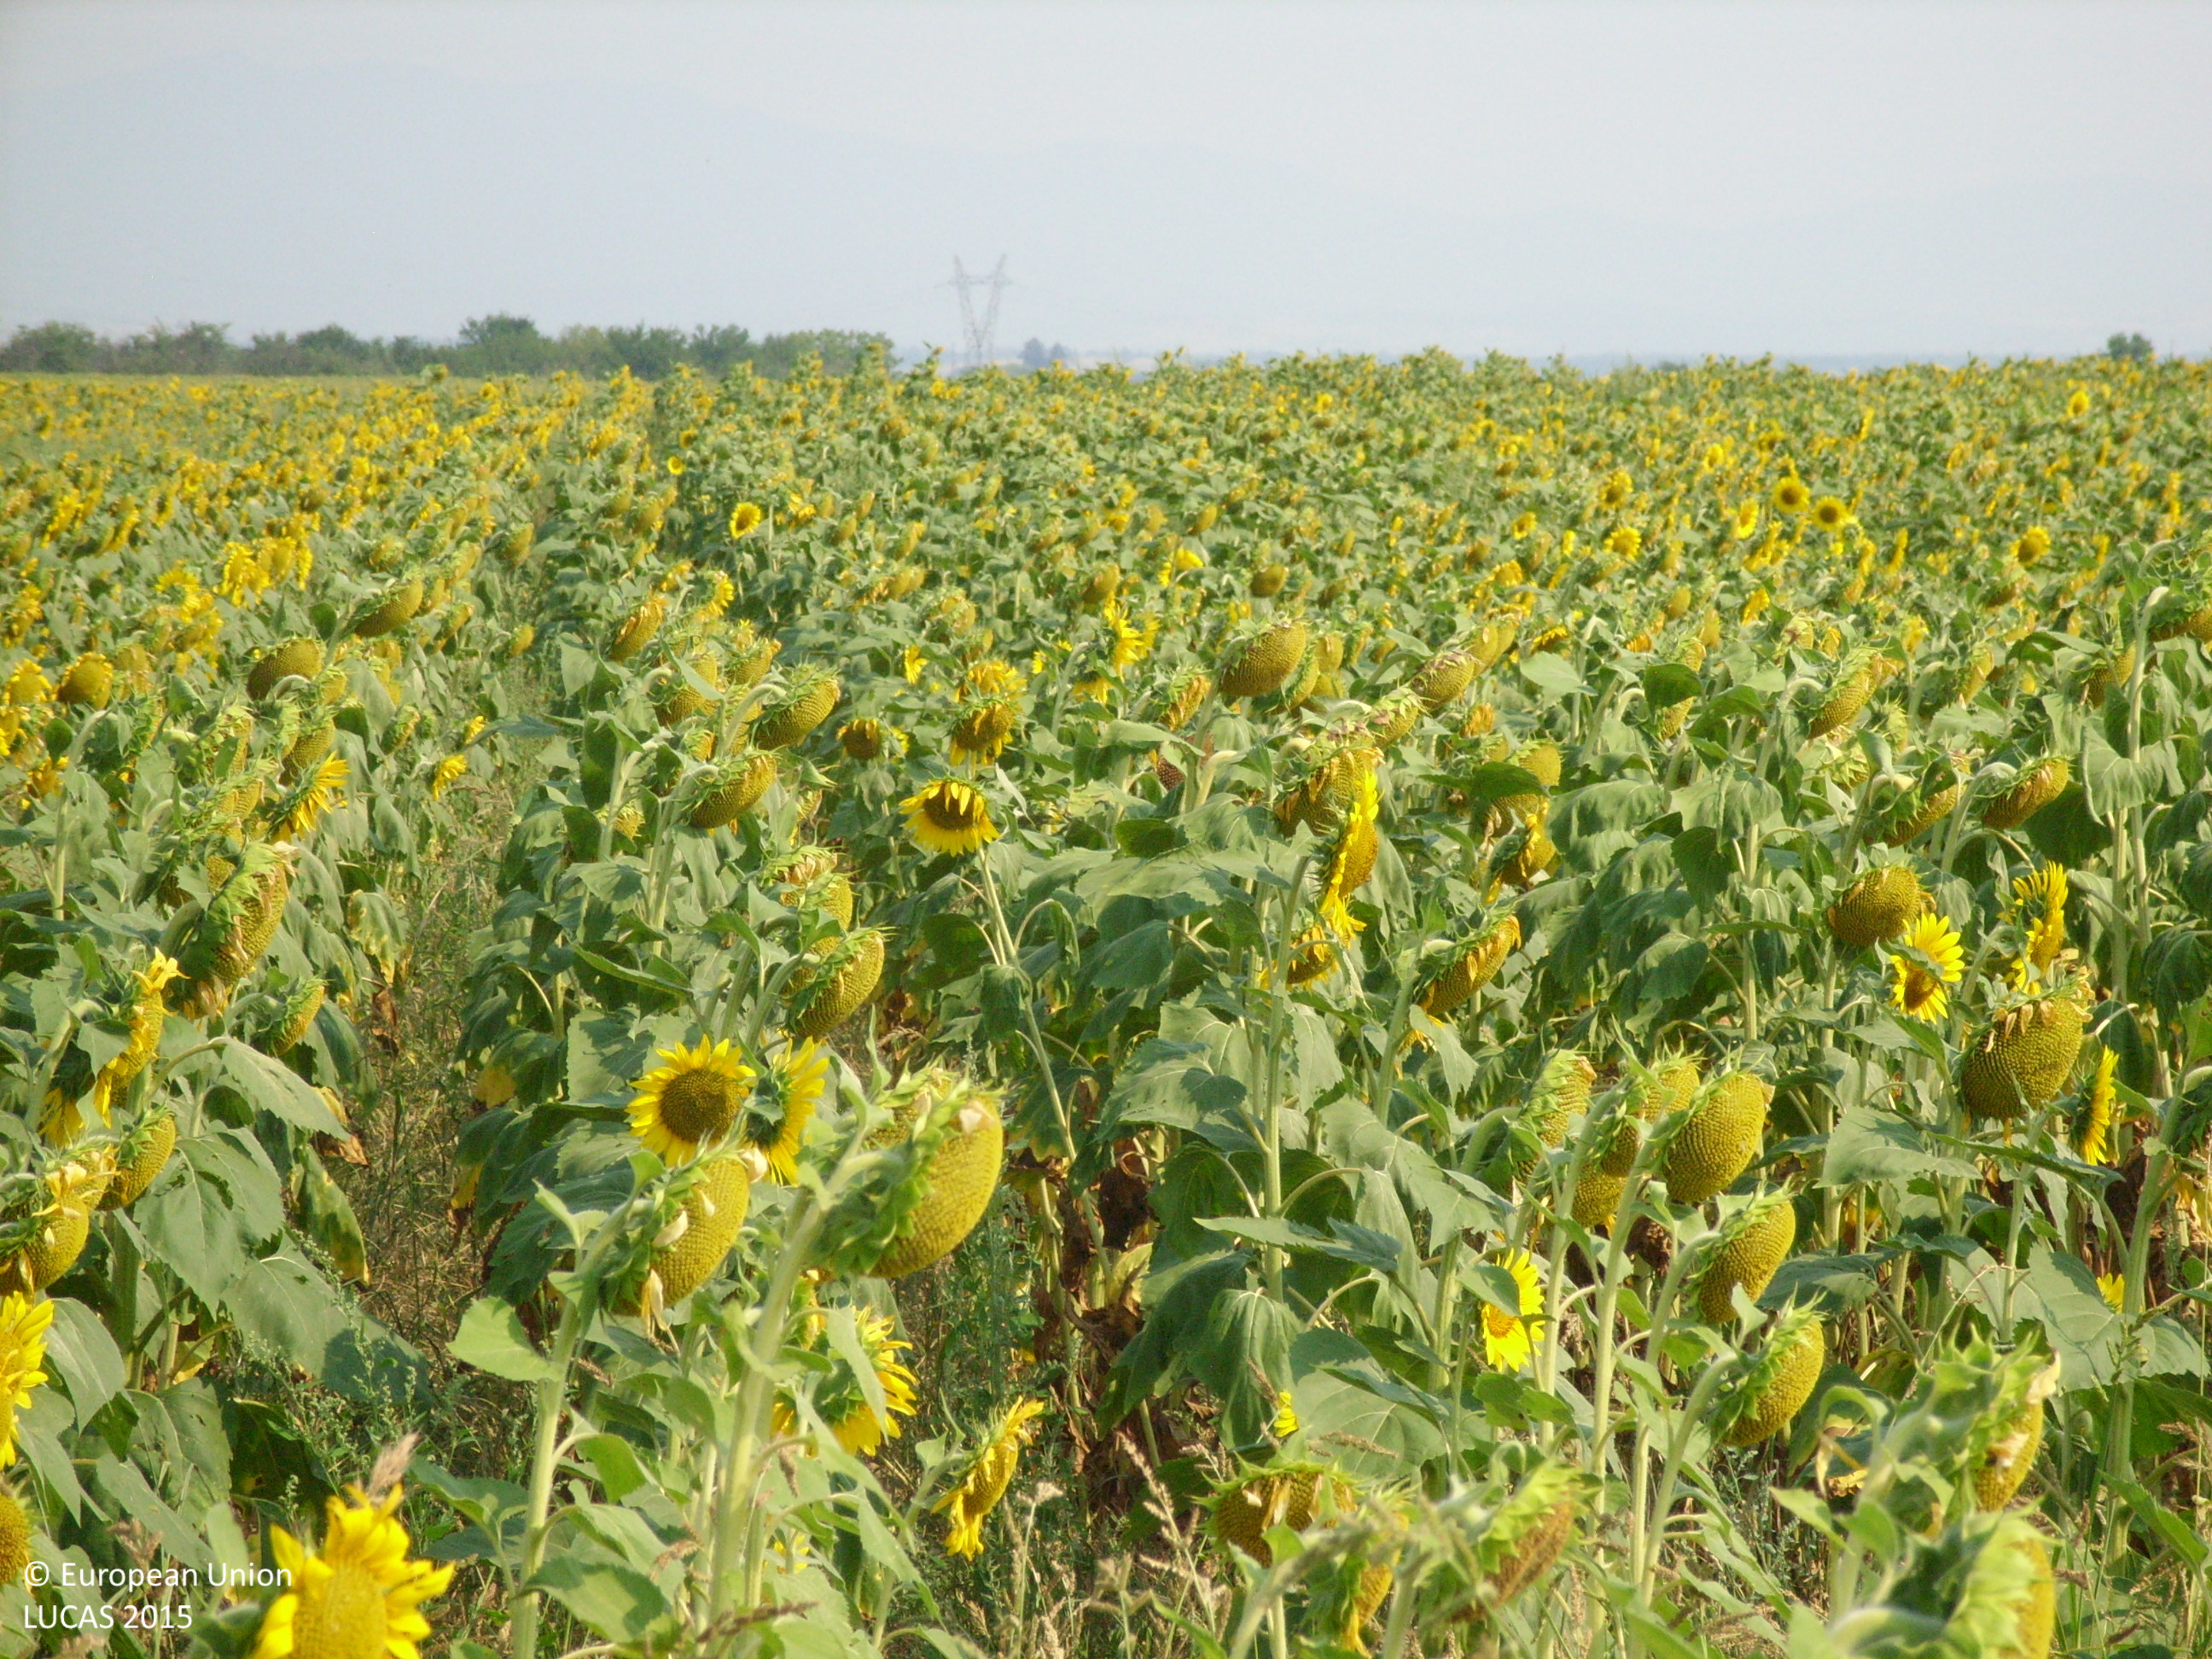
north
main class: Cropland
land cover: Sunflower
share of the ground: > 75 %
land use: Agriculture (excluding fallow land and kitchen gardens)
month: July
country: BG
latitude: 42.2978
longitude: 24.6431
